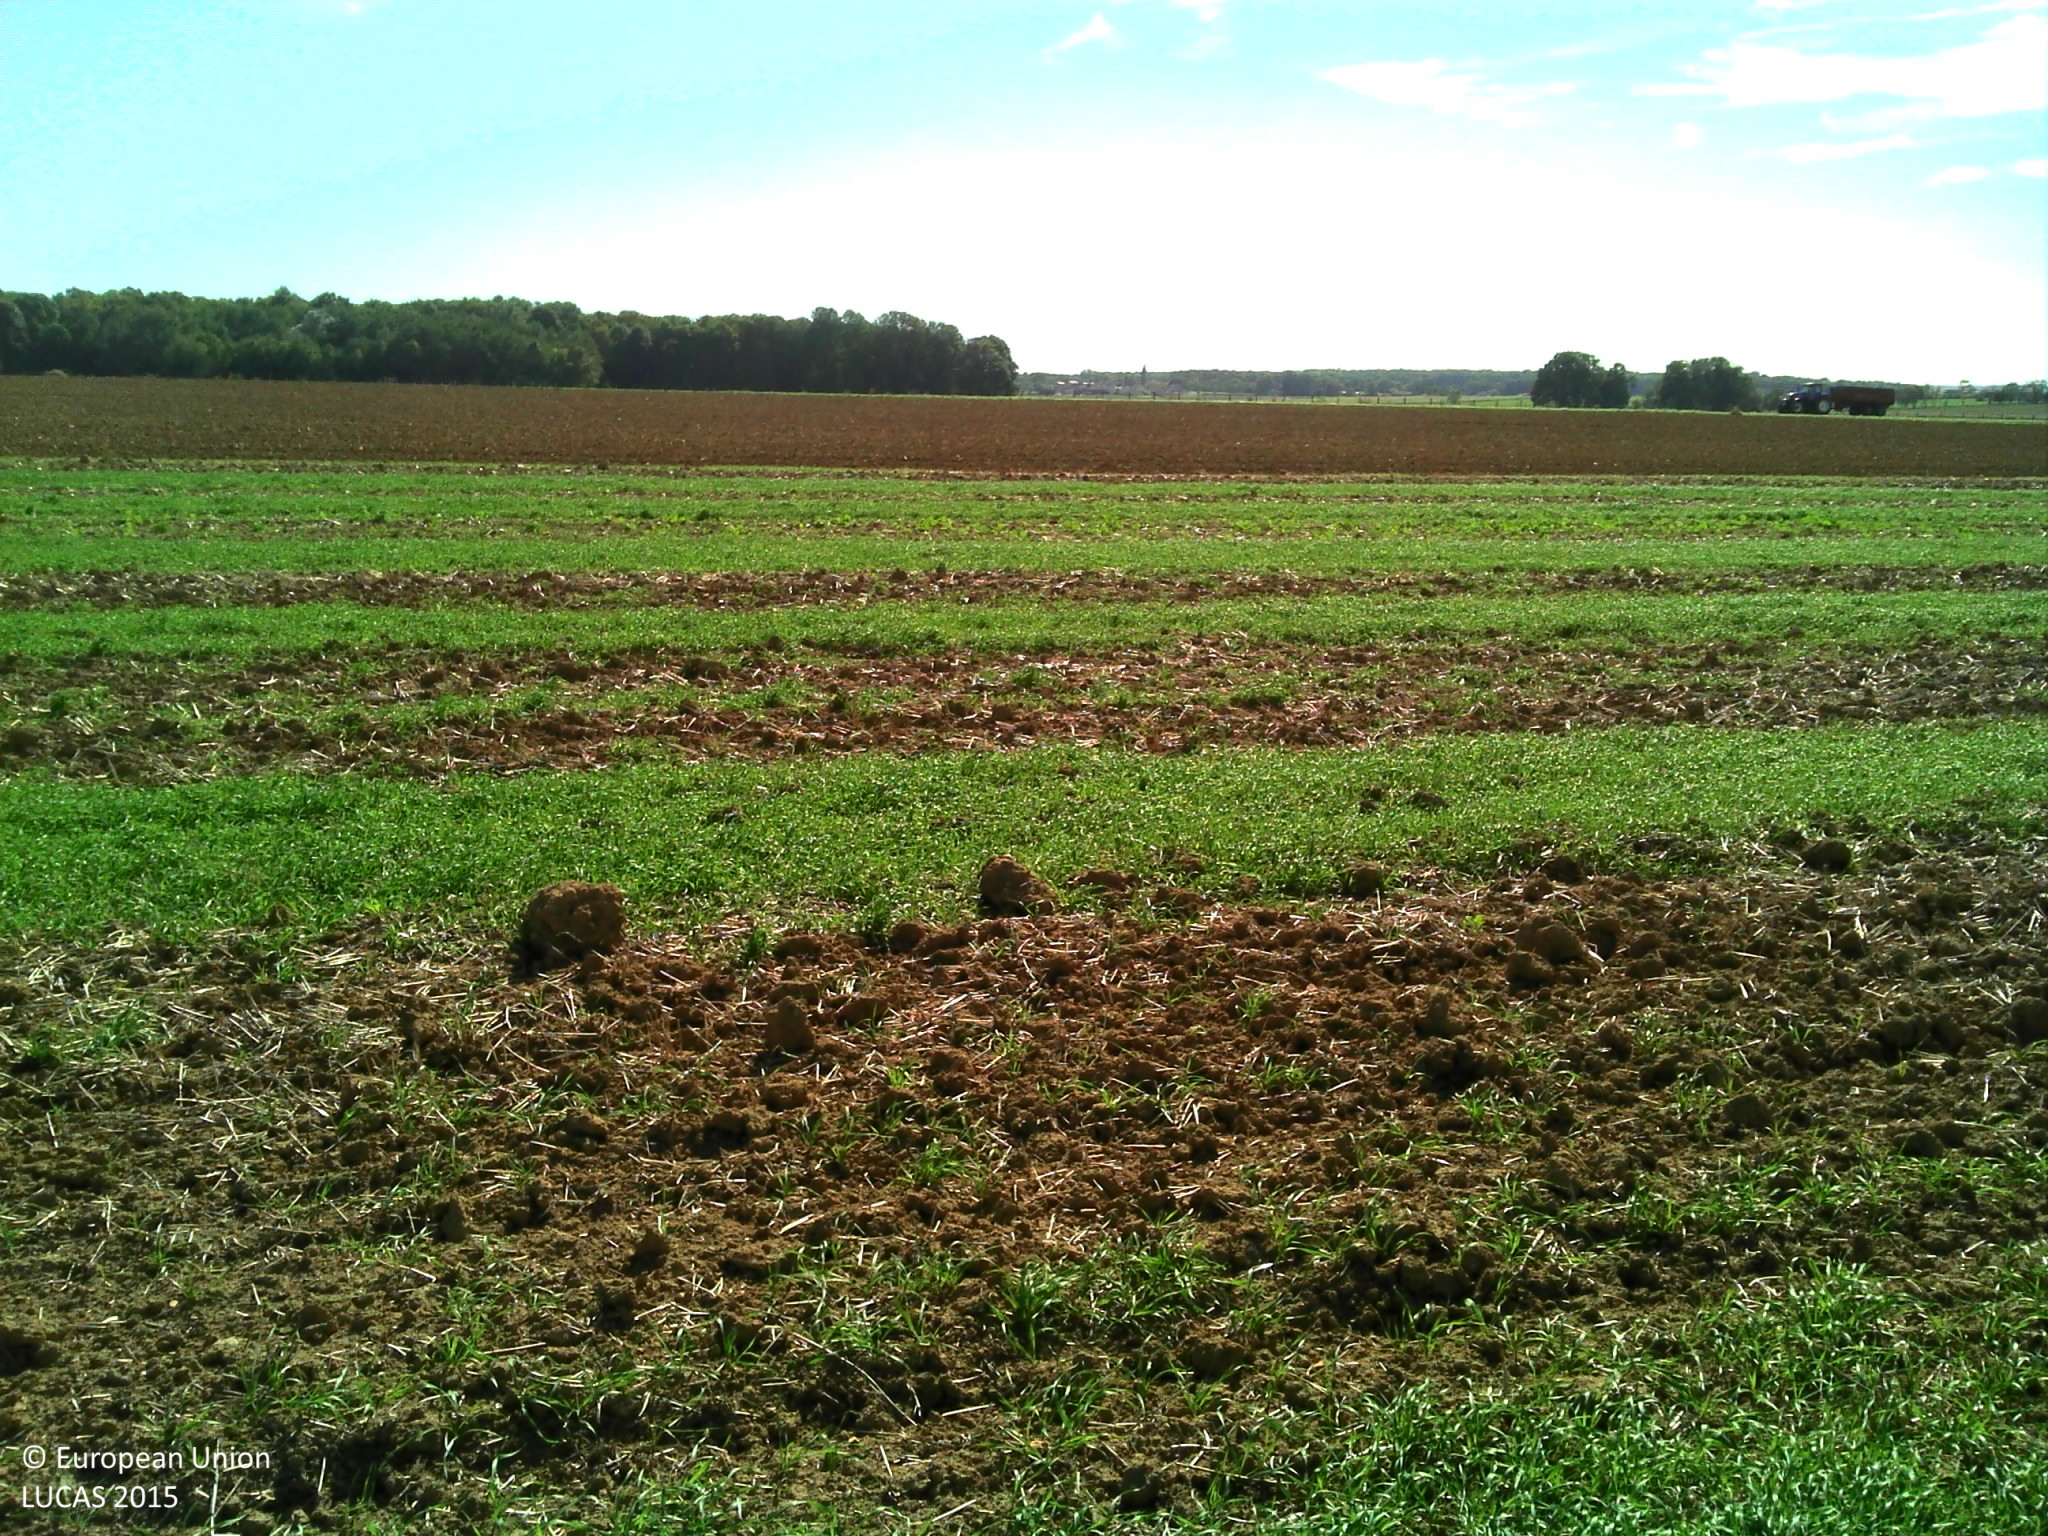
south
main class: Cropland
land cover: Common wheat
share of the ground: 10 - 25 %
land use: Agriculture (excluding fallow land and kitchen gardens)
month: September
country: FR
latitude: 48.3623
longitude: 4.6123
